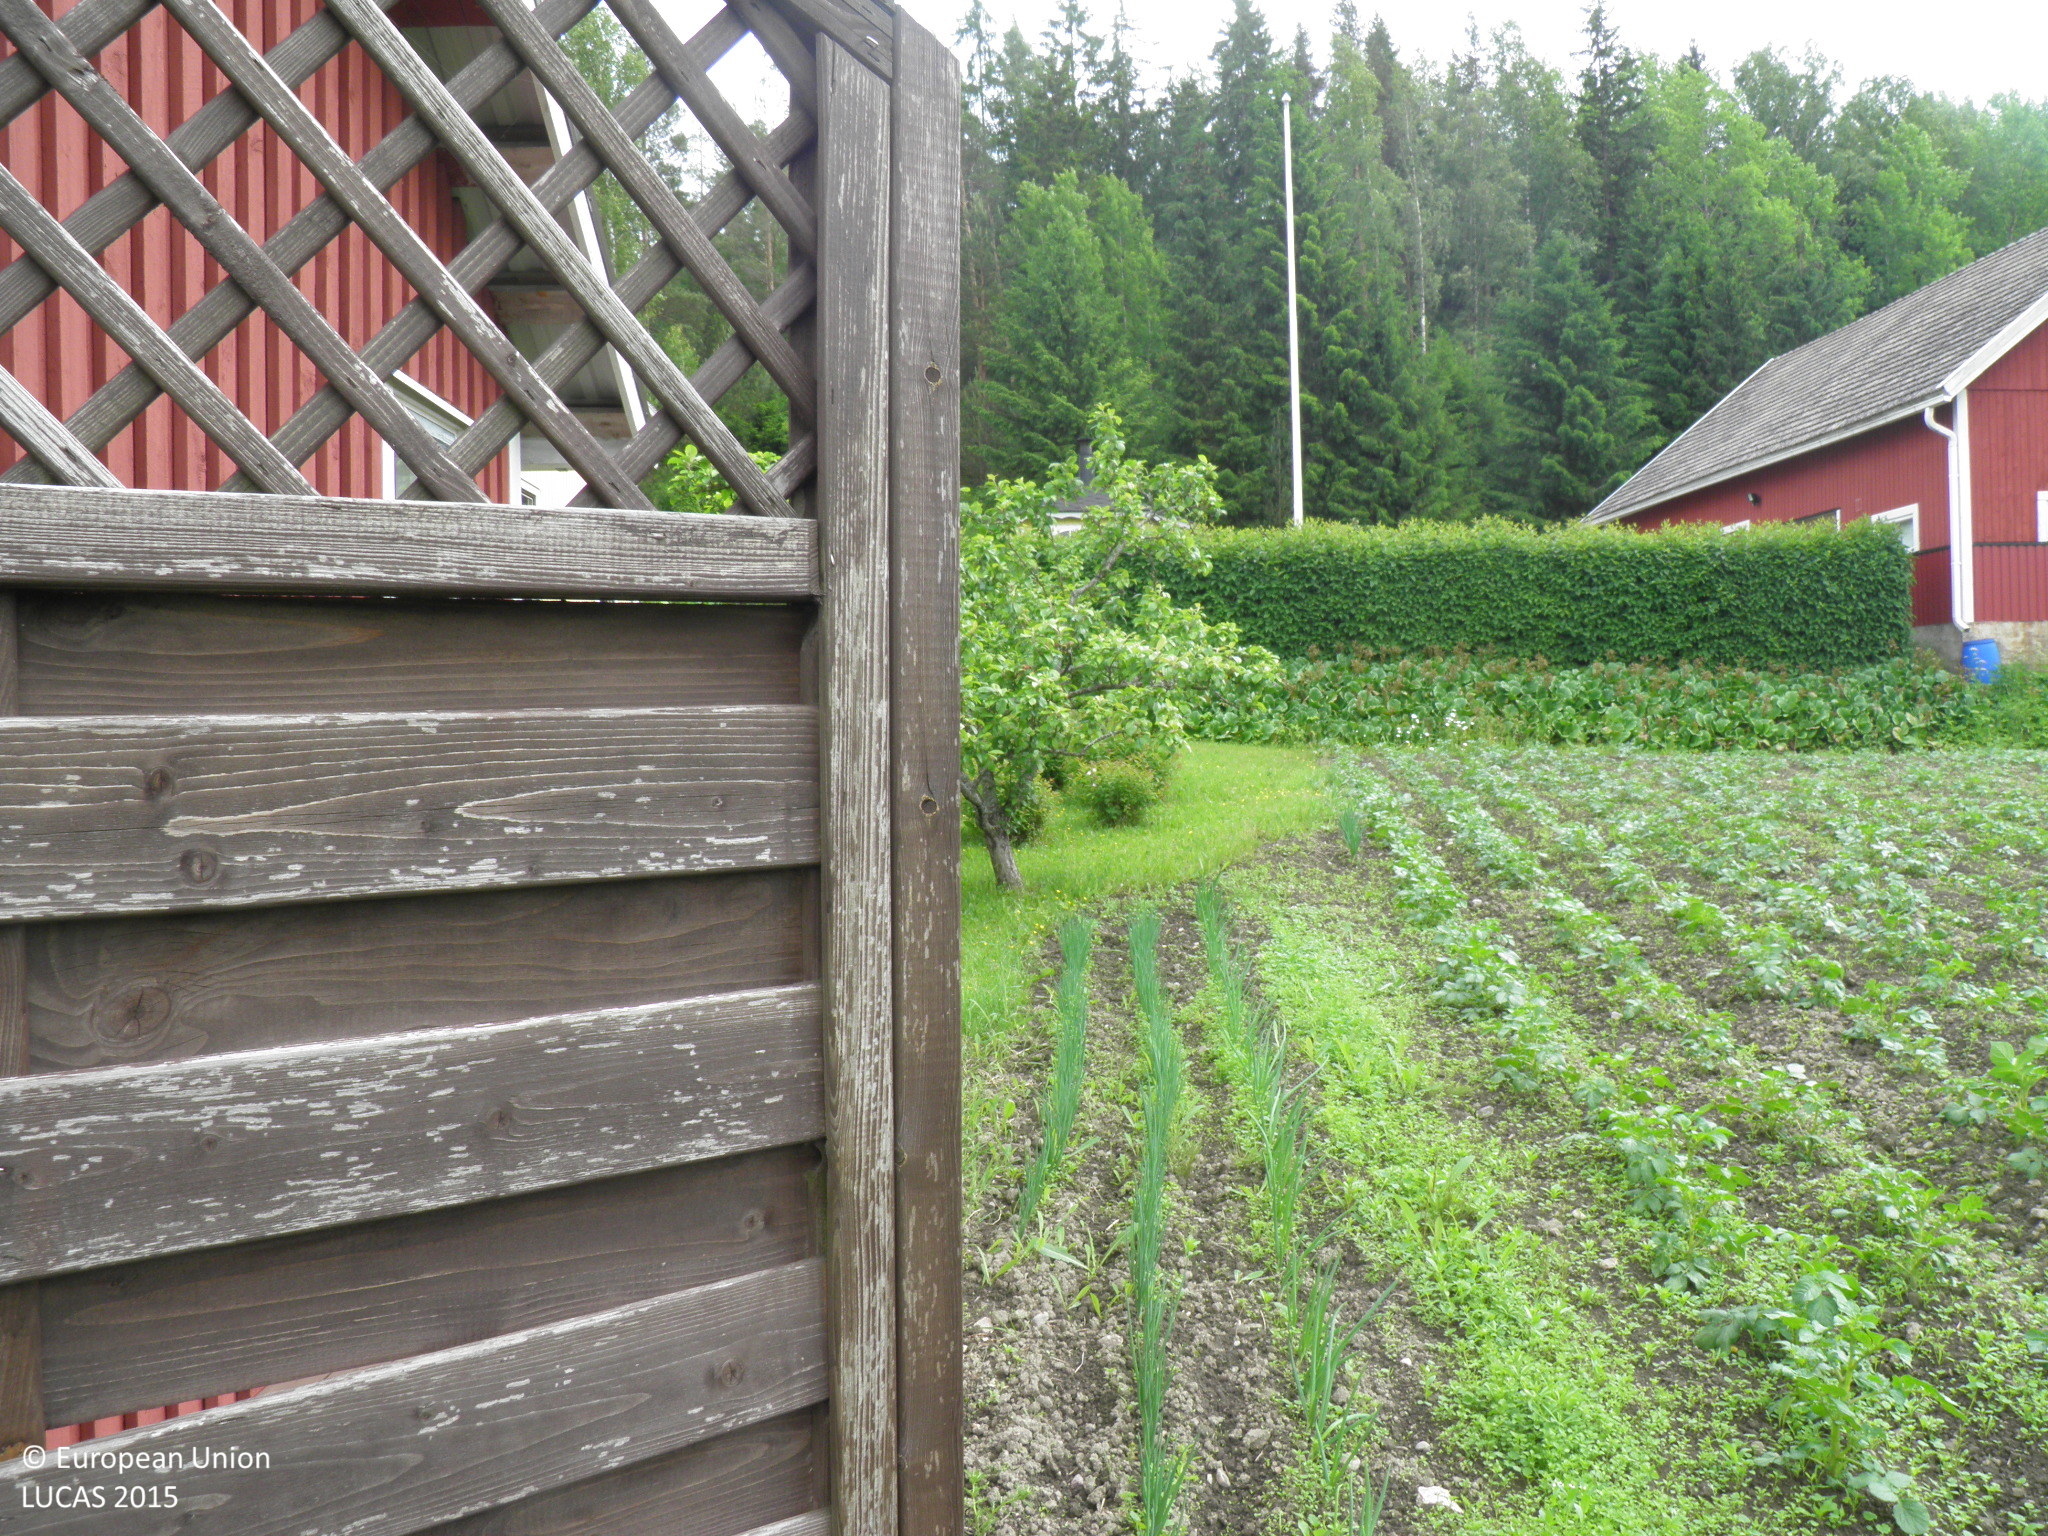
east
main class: Cropland
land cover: Common wheat
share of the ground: > 75 %
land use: Agriculture (excluding fallow land and kitchen gardens)
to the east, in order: Ditches and canals; Grass margins; Common wheat; Electric lines; Common wheat; Potatoes; Artificial constructions in urban areas; Spruce dominated mixed woodland; Ditches and canals; Grass margins; Oats; Grass margins; Ditches and canals; Other coniferous woodland; Pine dominated coniferous woodland; Other coniferous woodland
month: June
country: FI
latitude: 60.3968
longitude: 23.0185
